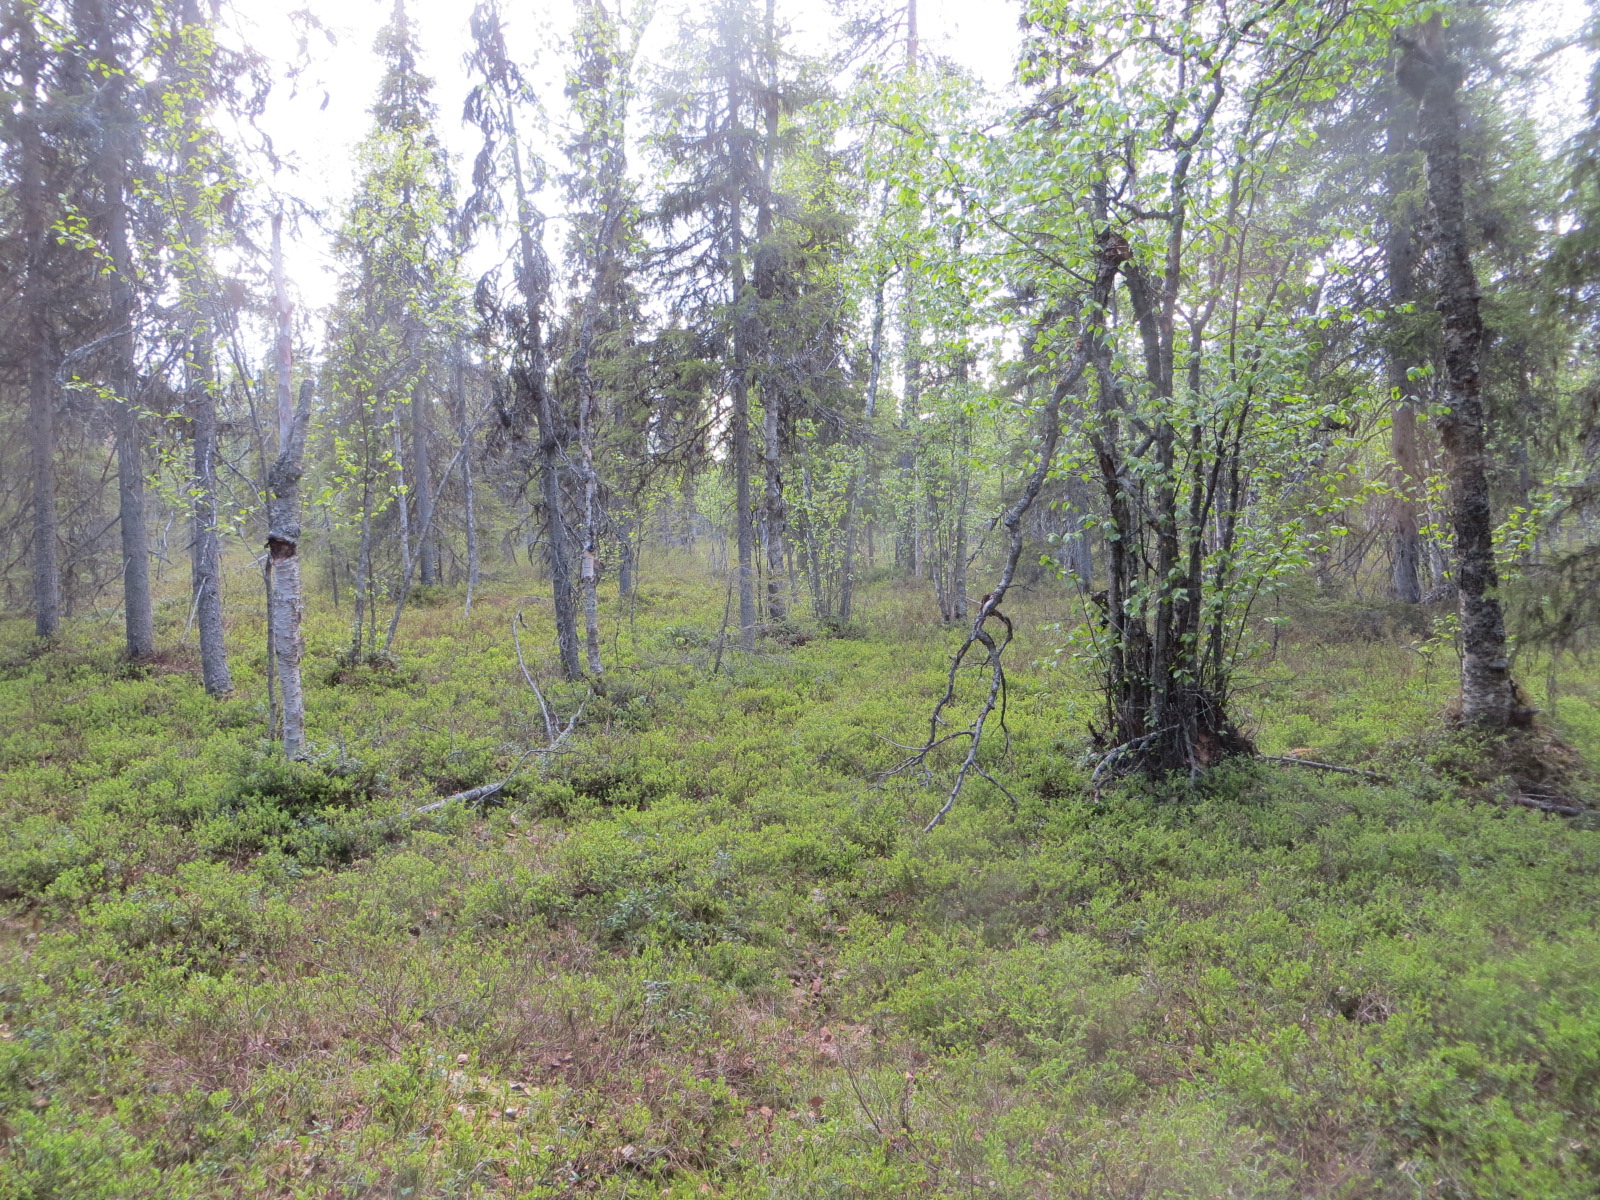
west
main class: Woodland
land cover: Spruce dominated mixed woodland
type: boreal forest
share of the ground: 50 - 75 %
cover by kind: coniferous forest trees 60 %, broadleaved forest trees 20 %, shrubs 20 %
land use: Forestry
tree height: > 5 m
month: June
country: FI
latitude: 67.4881
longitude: 25.8548
